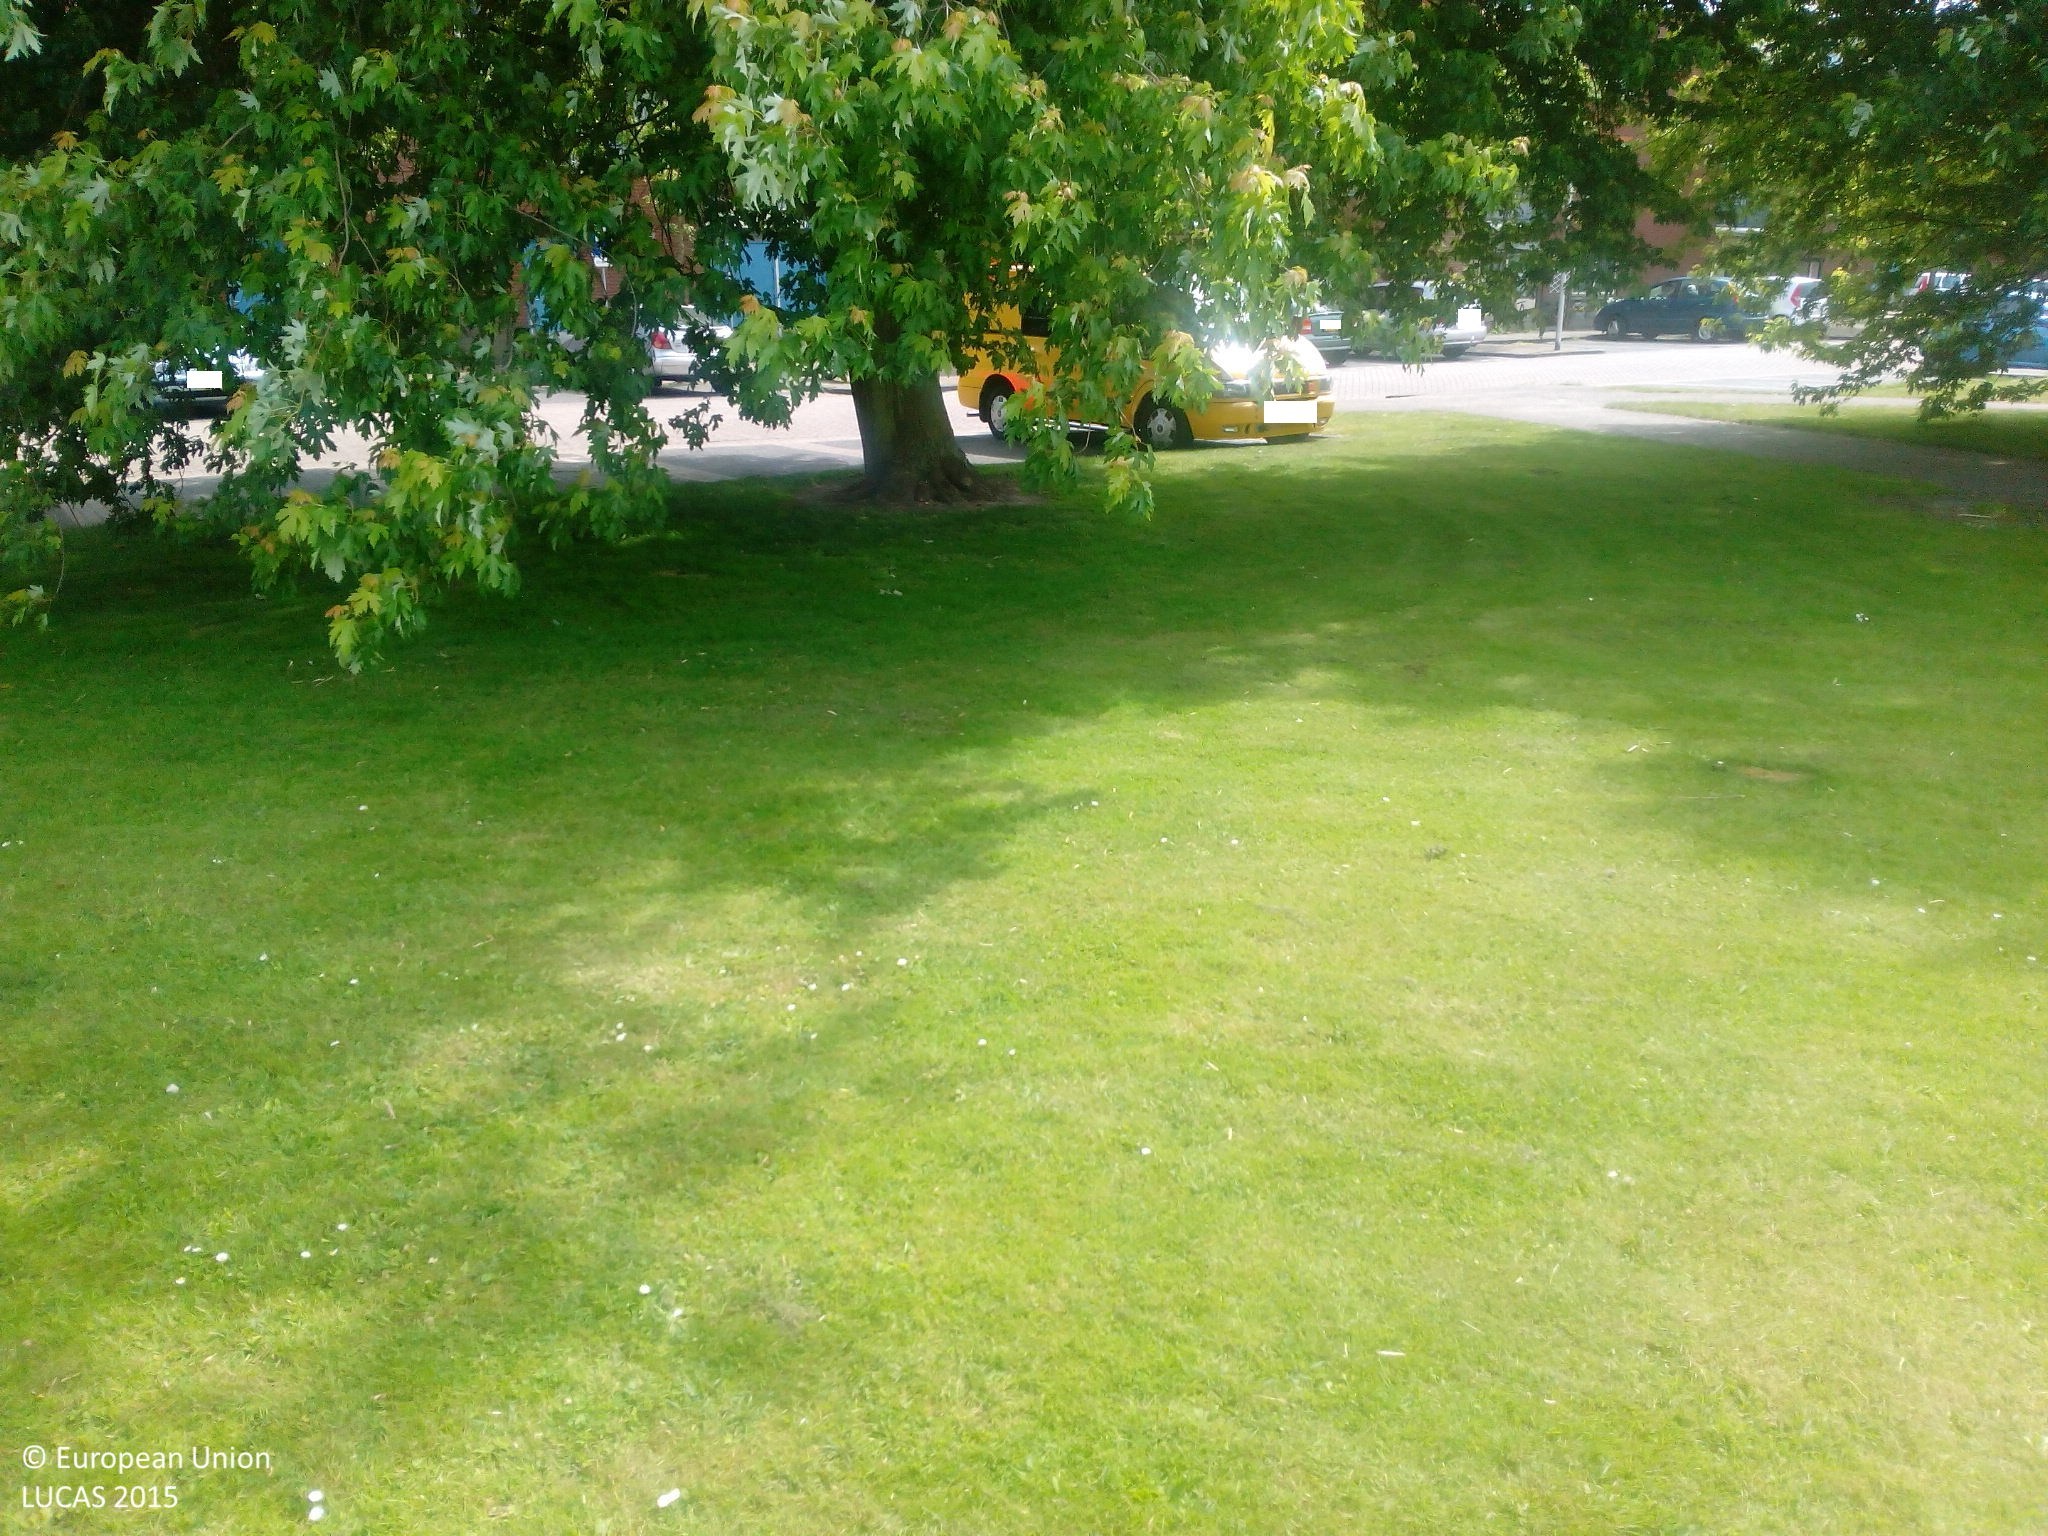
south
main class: Woodland
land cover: Broadleaved woodland
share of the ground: 25 - 50 %
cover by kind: herbaceous plants 55 %, broadleaved forest trees 30 %, consolidated bare surface 15 %
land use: Residential
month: June
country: NL
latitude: 51.8366
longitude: 4.1460
